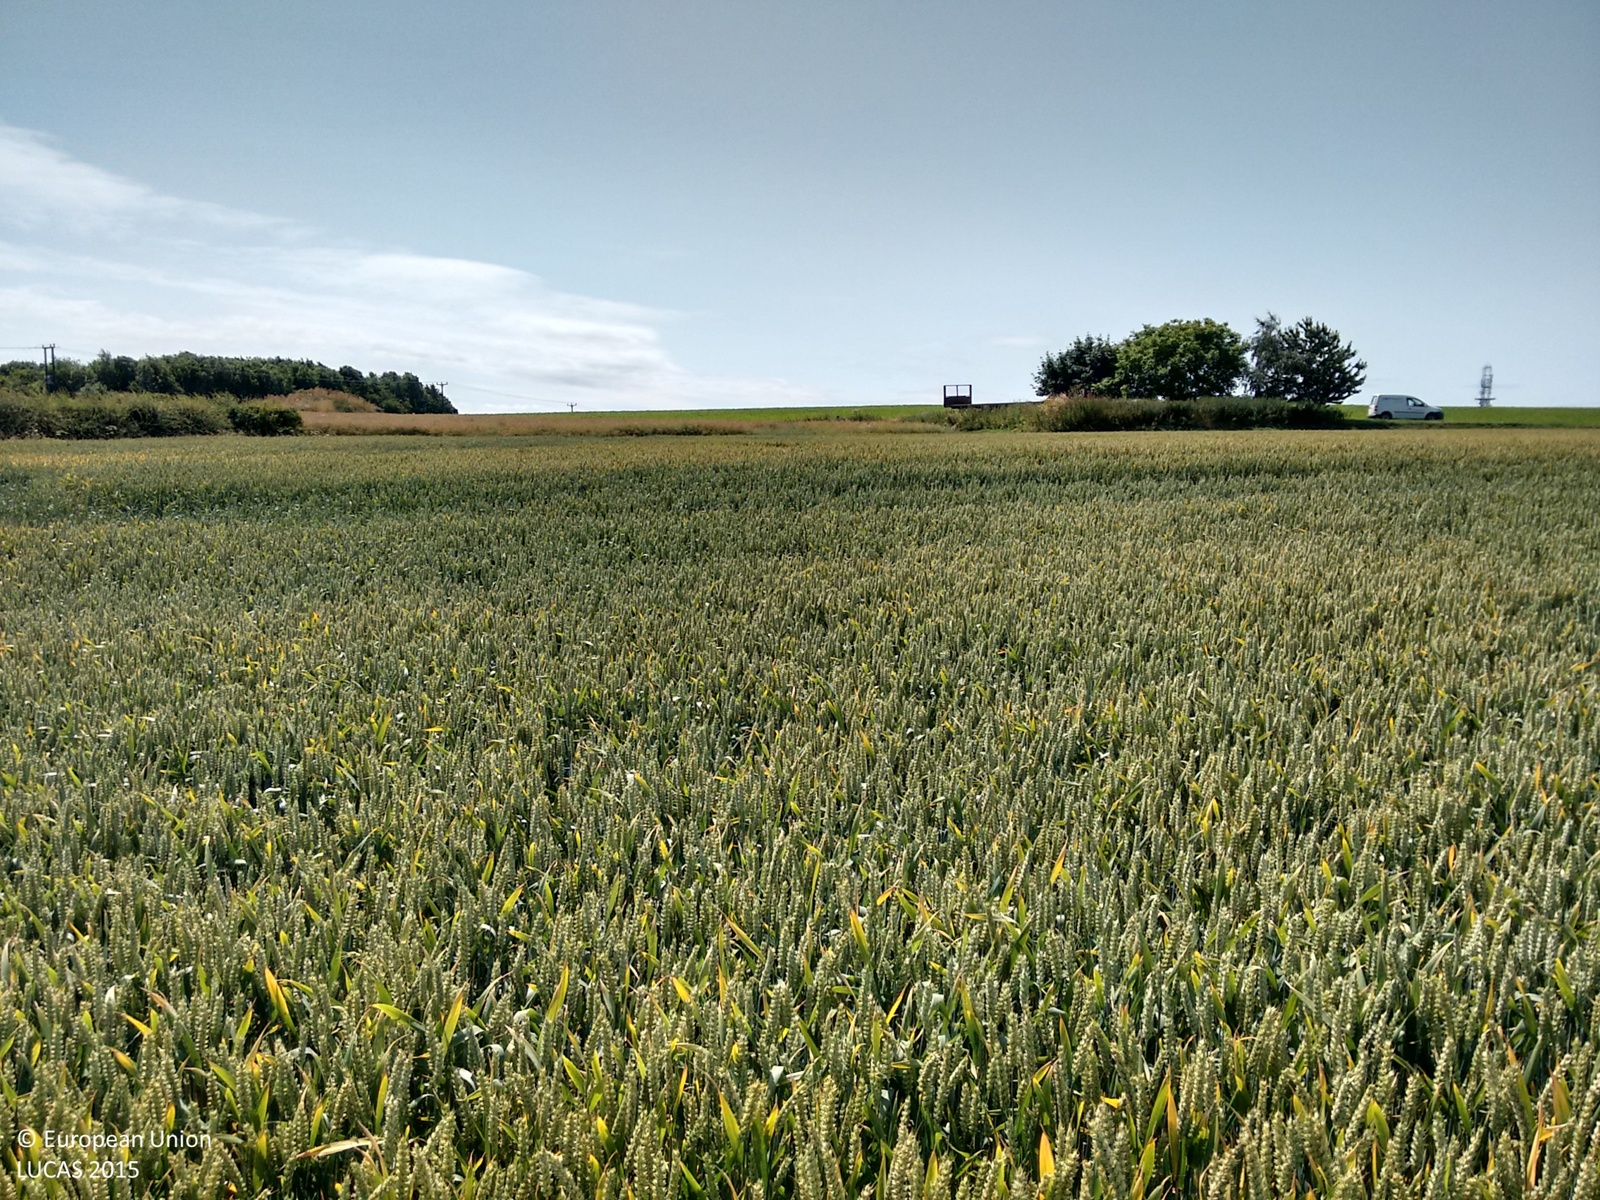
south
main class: Cropland
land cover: Rape and turnip rape
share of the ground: > 75 %
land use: Agriculture (excluding fallow land and kitchen gardens)
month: July
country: GB
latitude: 53.2319
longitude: -0.9340
